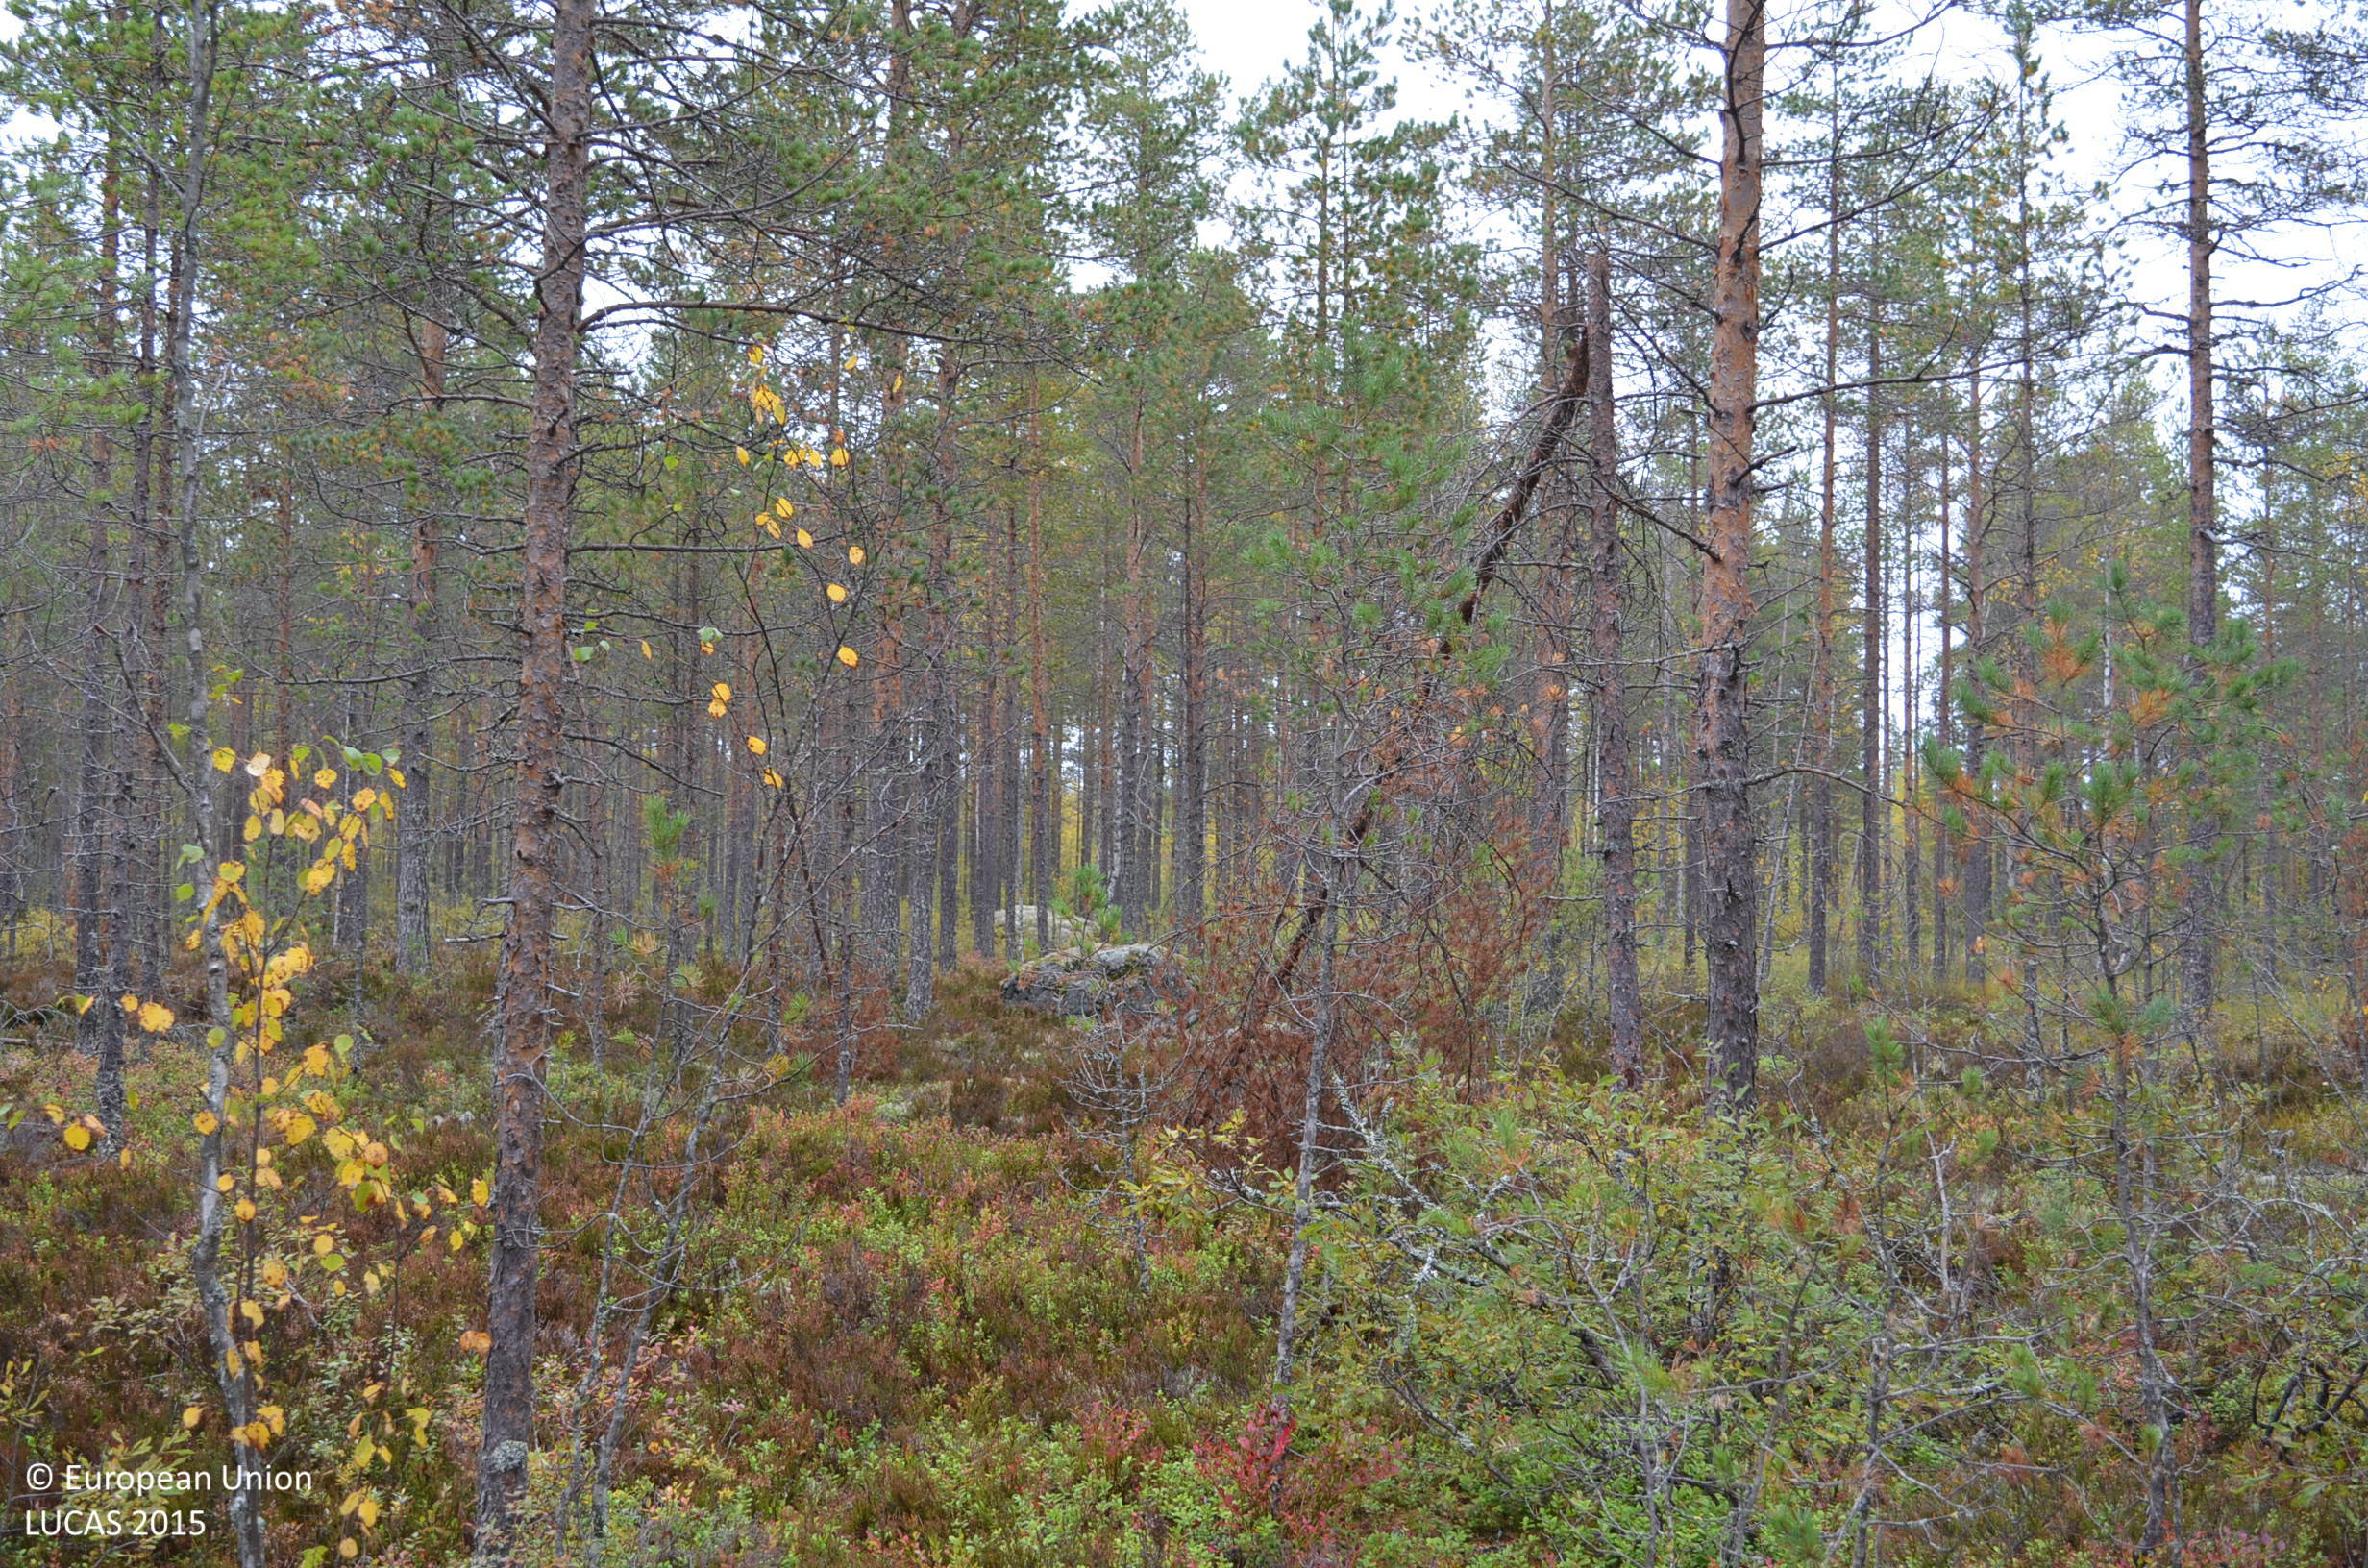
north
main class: Woodland
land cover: Pine dominated coniferous woodland
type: boreal forest
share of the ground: 50 - 75 %
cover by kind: coniferous forest trees 60 %, shrubs 35 %, broadleaved forest trees 5 %
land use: Forestry
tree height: > 5 m
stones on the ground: < 10 %
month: September
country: FI
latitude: 62.8431
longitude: 23.7205
